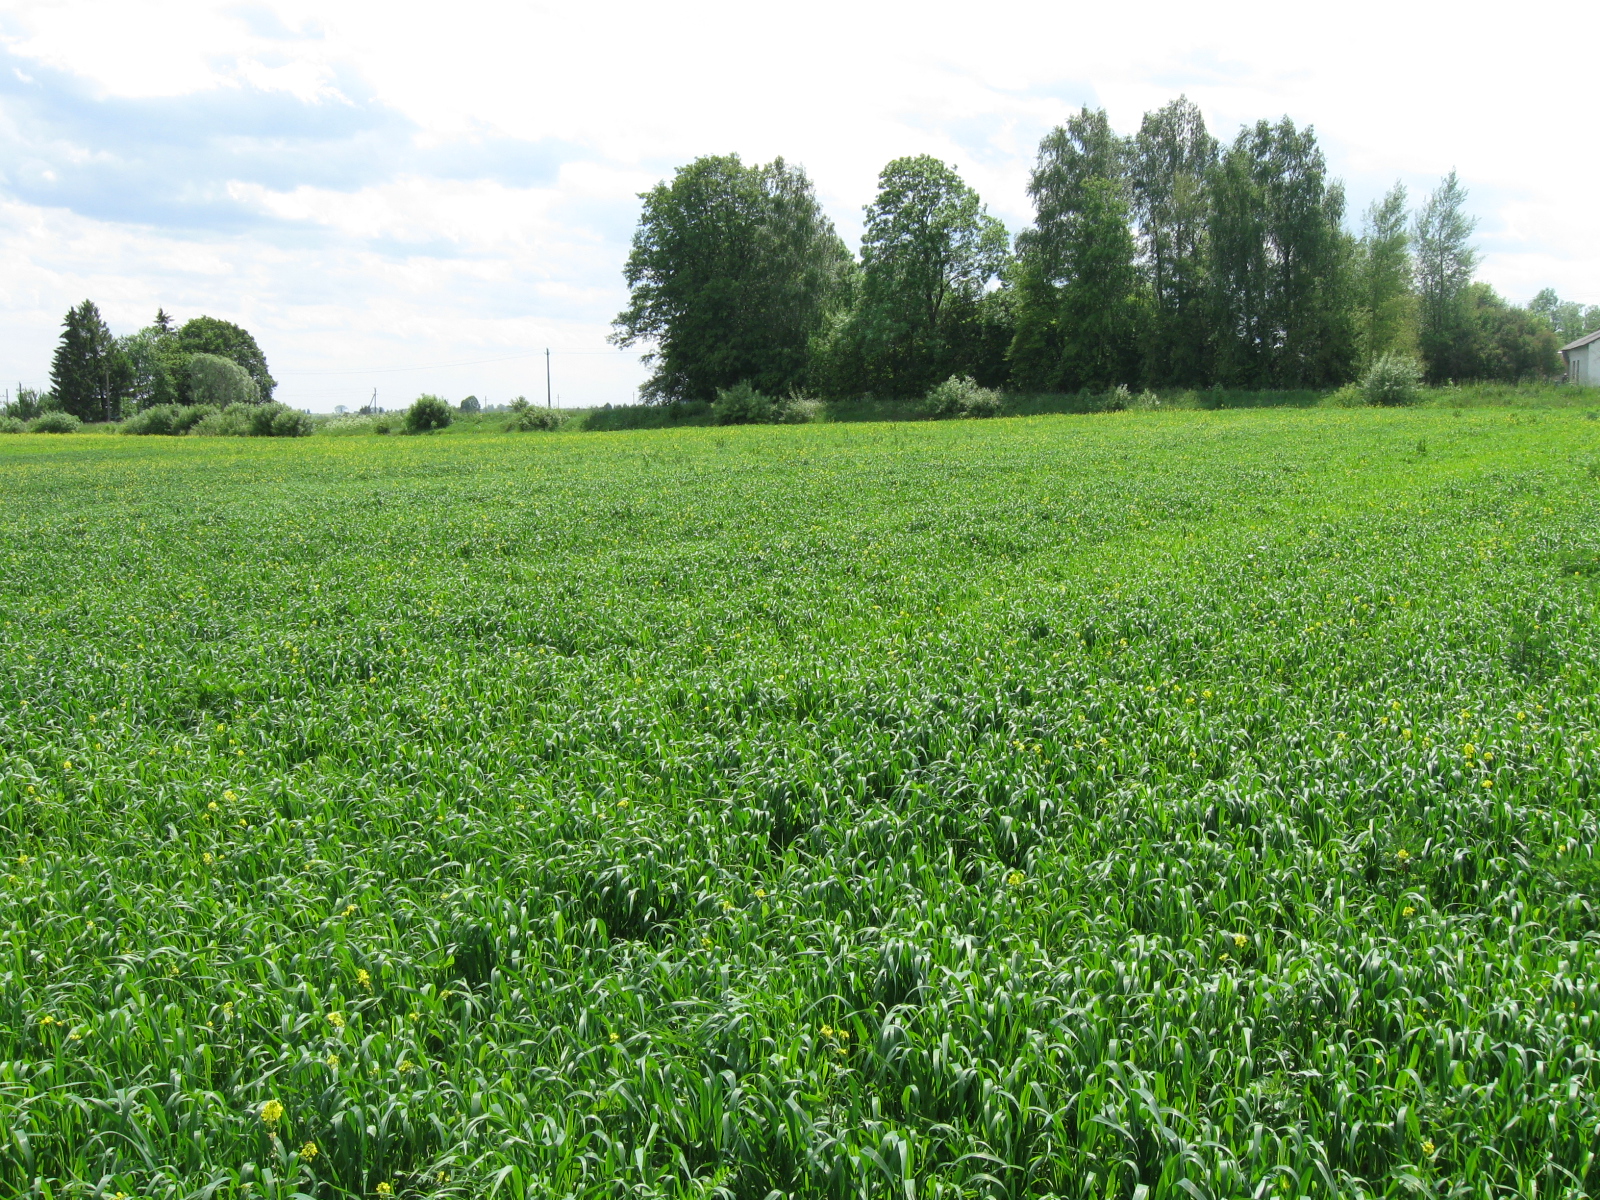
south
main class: Cropland
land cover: Oats
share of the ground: > 75 %
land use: Agriculture (excluding fallow land and kitchen gardens)
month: June
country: LT
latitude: 54.3595
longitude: 23.7995
